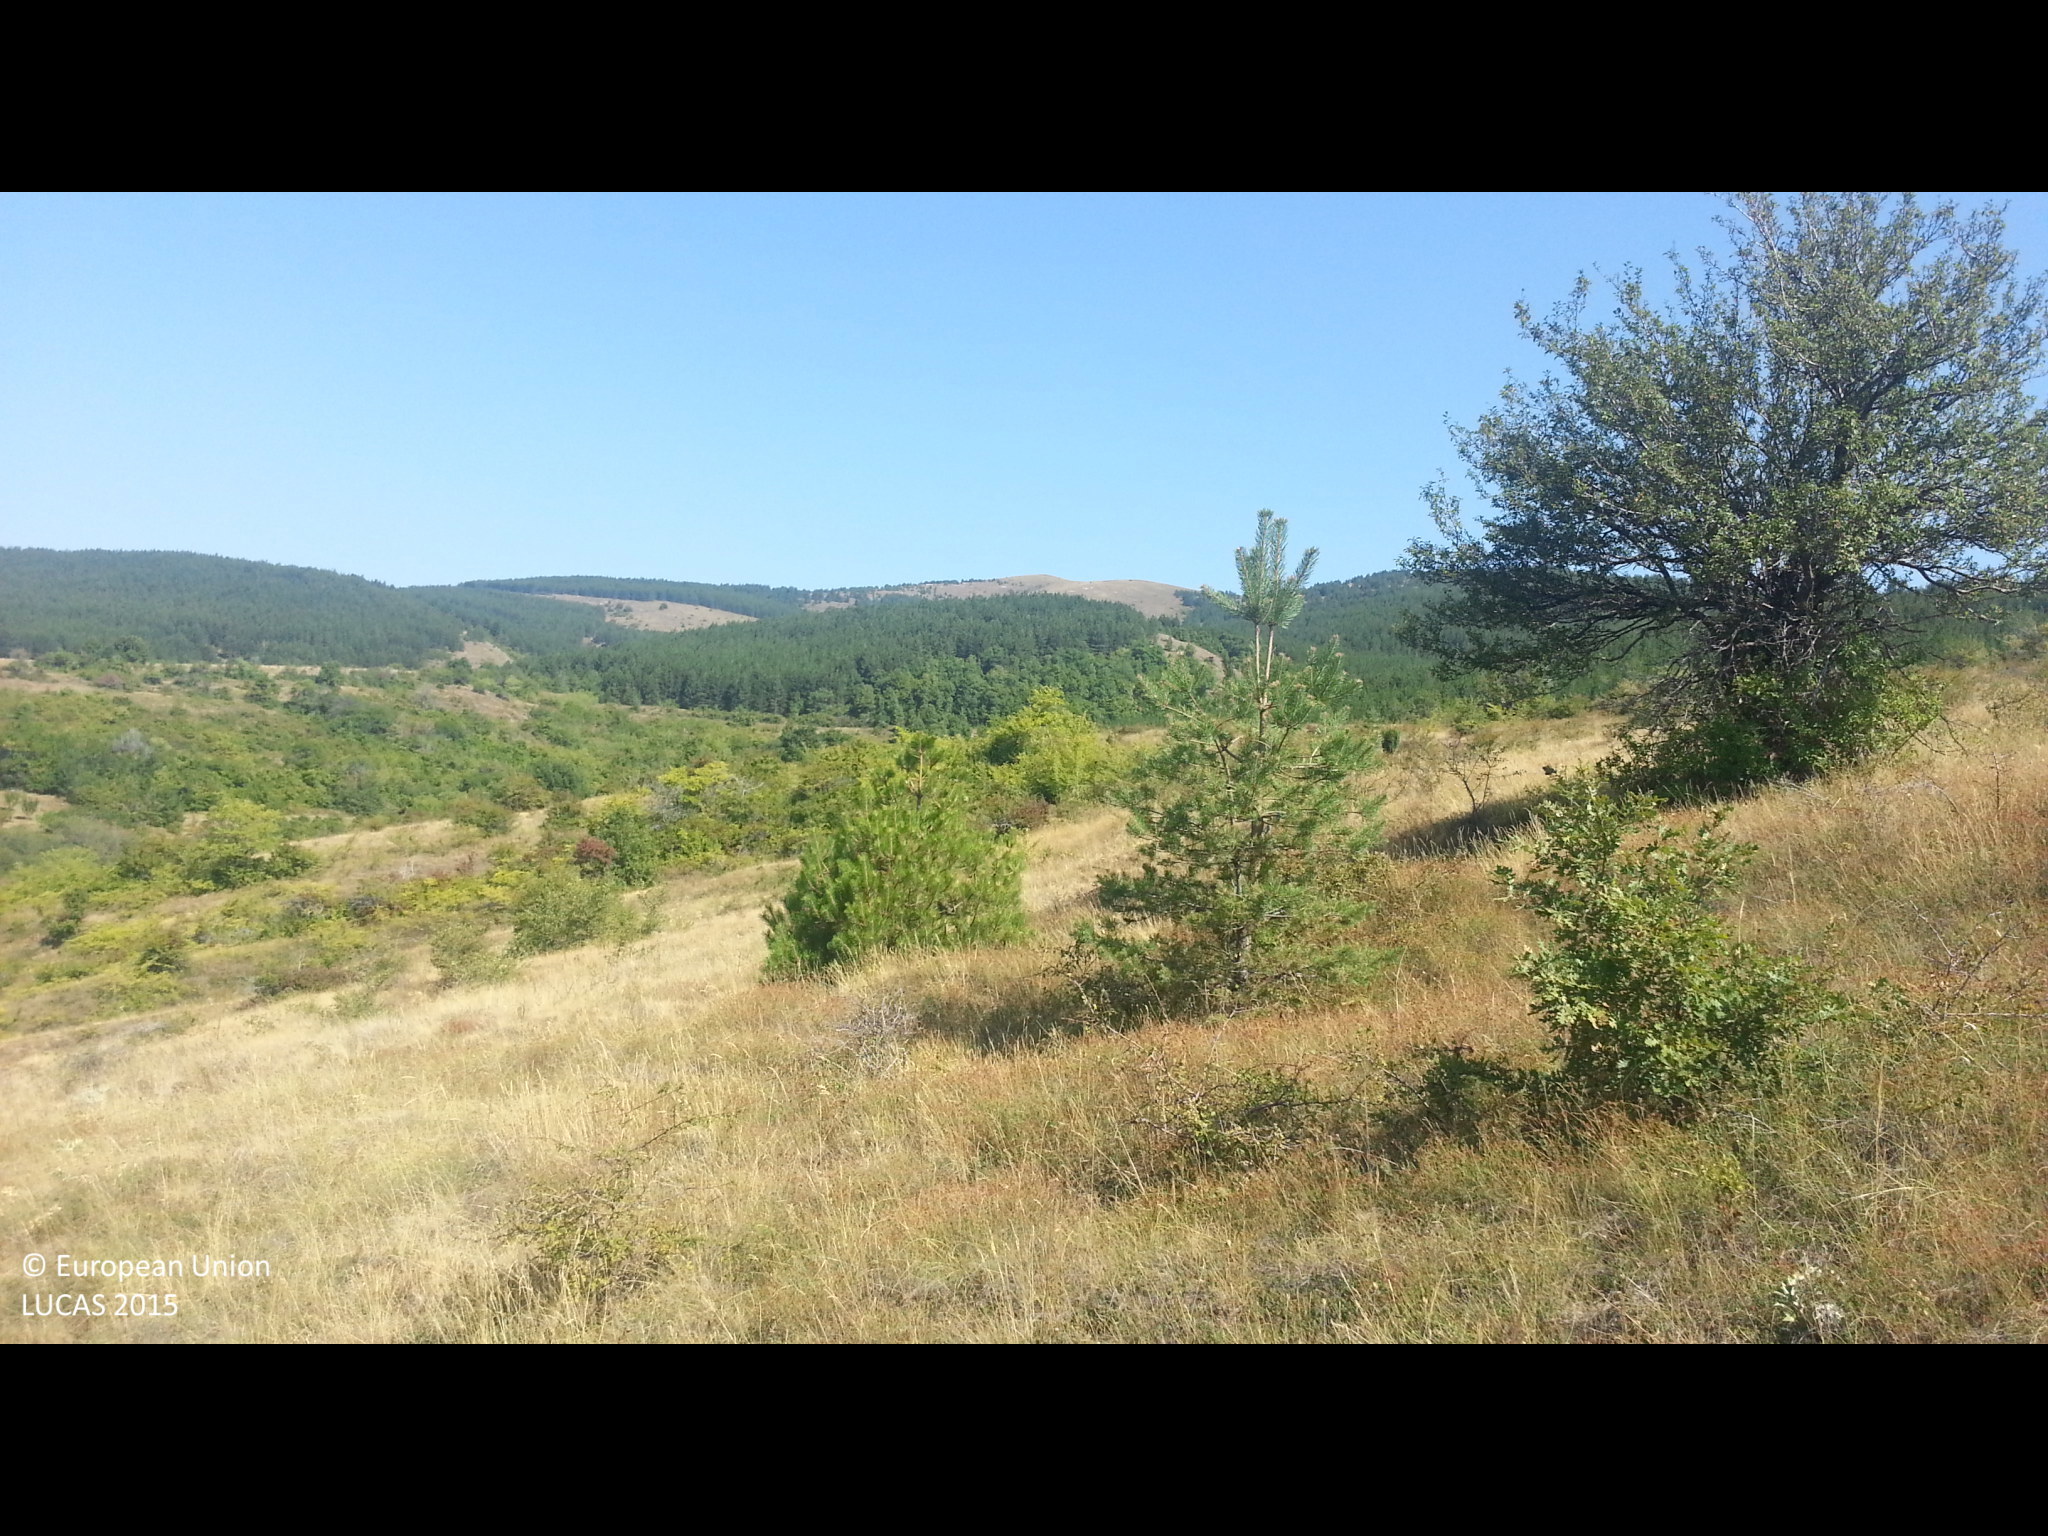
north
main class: Grassland
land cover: Grassland with sparse tree/shrub cover
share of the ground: > 75 %
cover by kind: herbaceous plants 90 %, broadleaved forest trees 5 %, shrubs 5 %
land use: Agriculture (excluding fallow land and kitchen gardens)
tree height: < 5 m
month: August
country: BG
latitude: 42.4923
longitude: 23.1088
